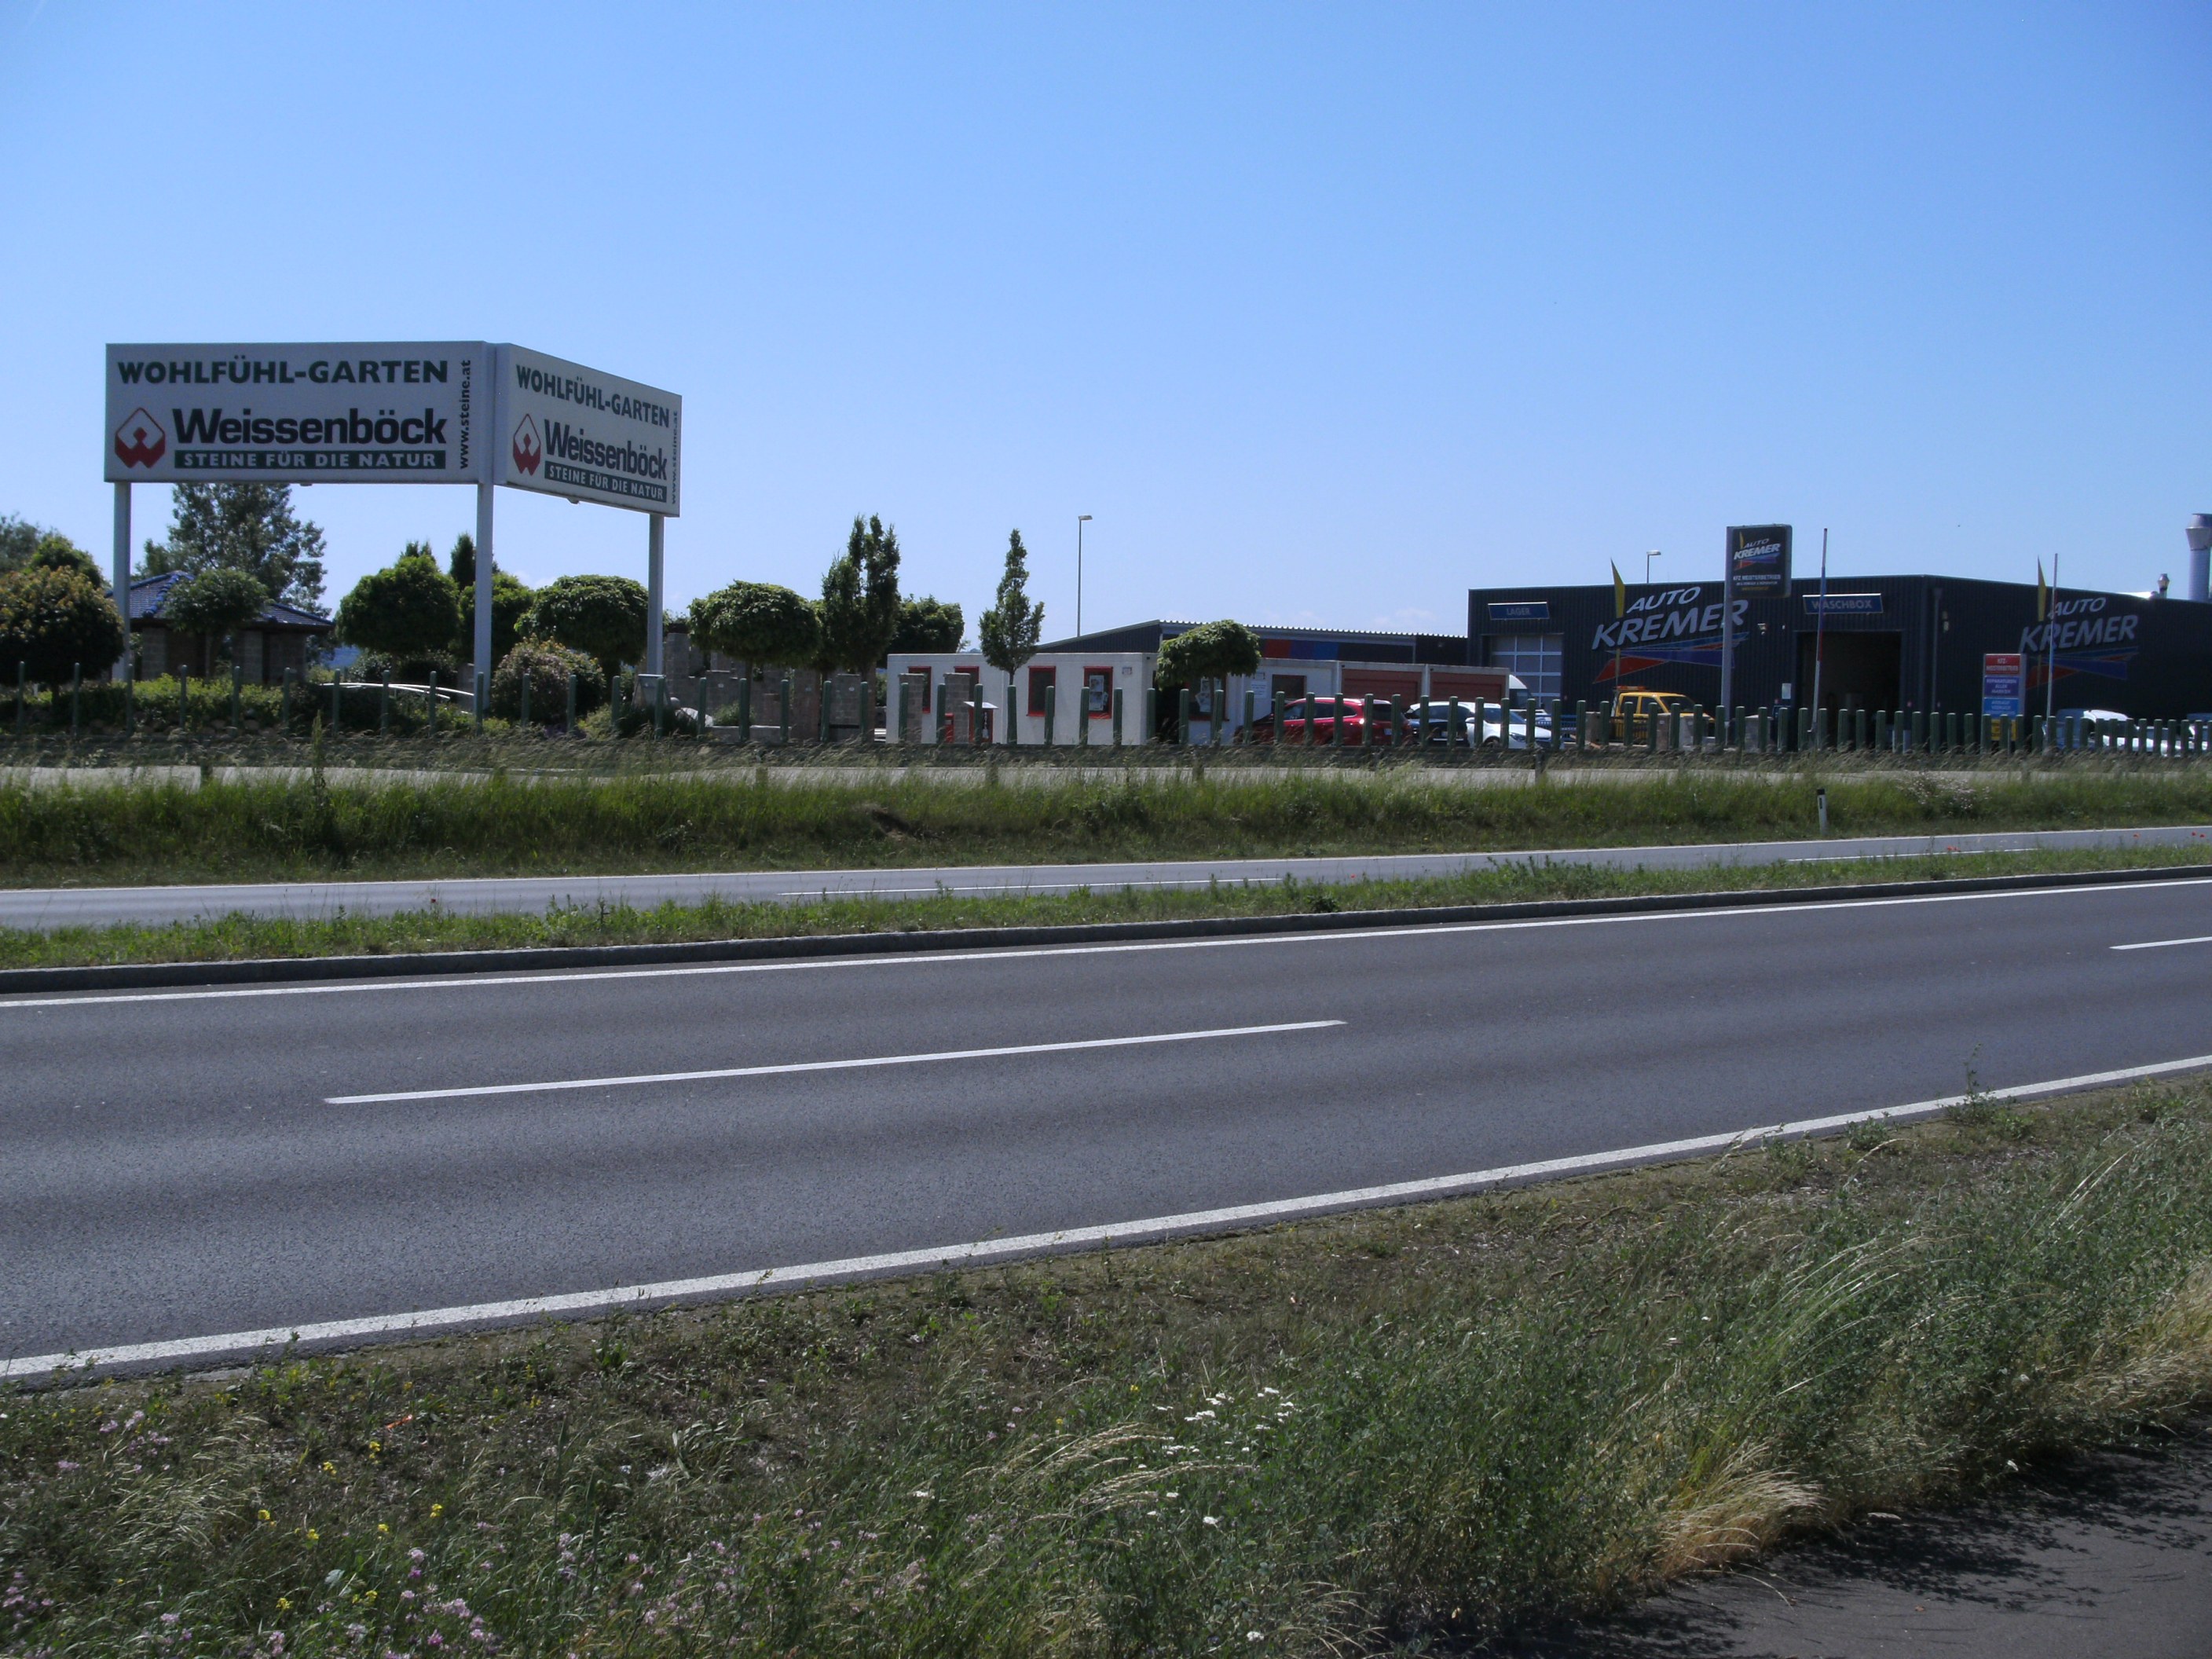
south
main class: Grassland
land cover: Spontaneously vegetated surfaces
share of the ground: > 75 %
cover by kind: herbaceous plants 100 %
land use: Fallow land
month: June
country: AT
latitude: 48.2162
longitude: 14.1856
